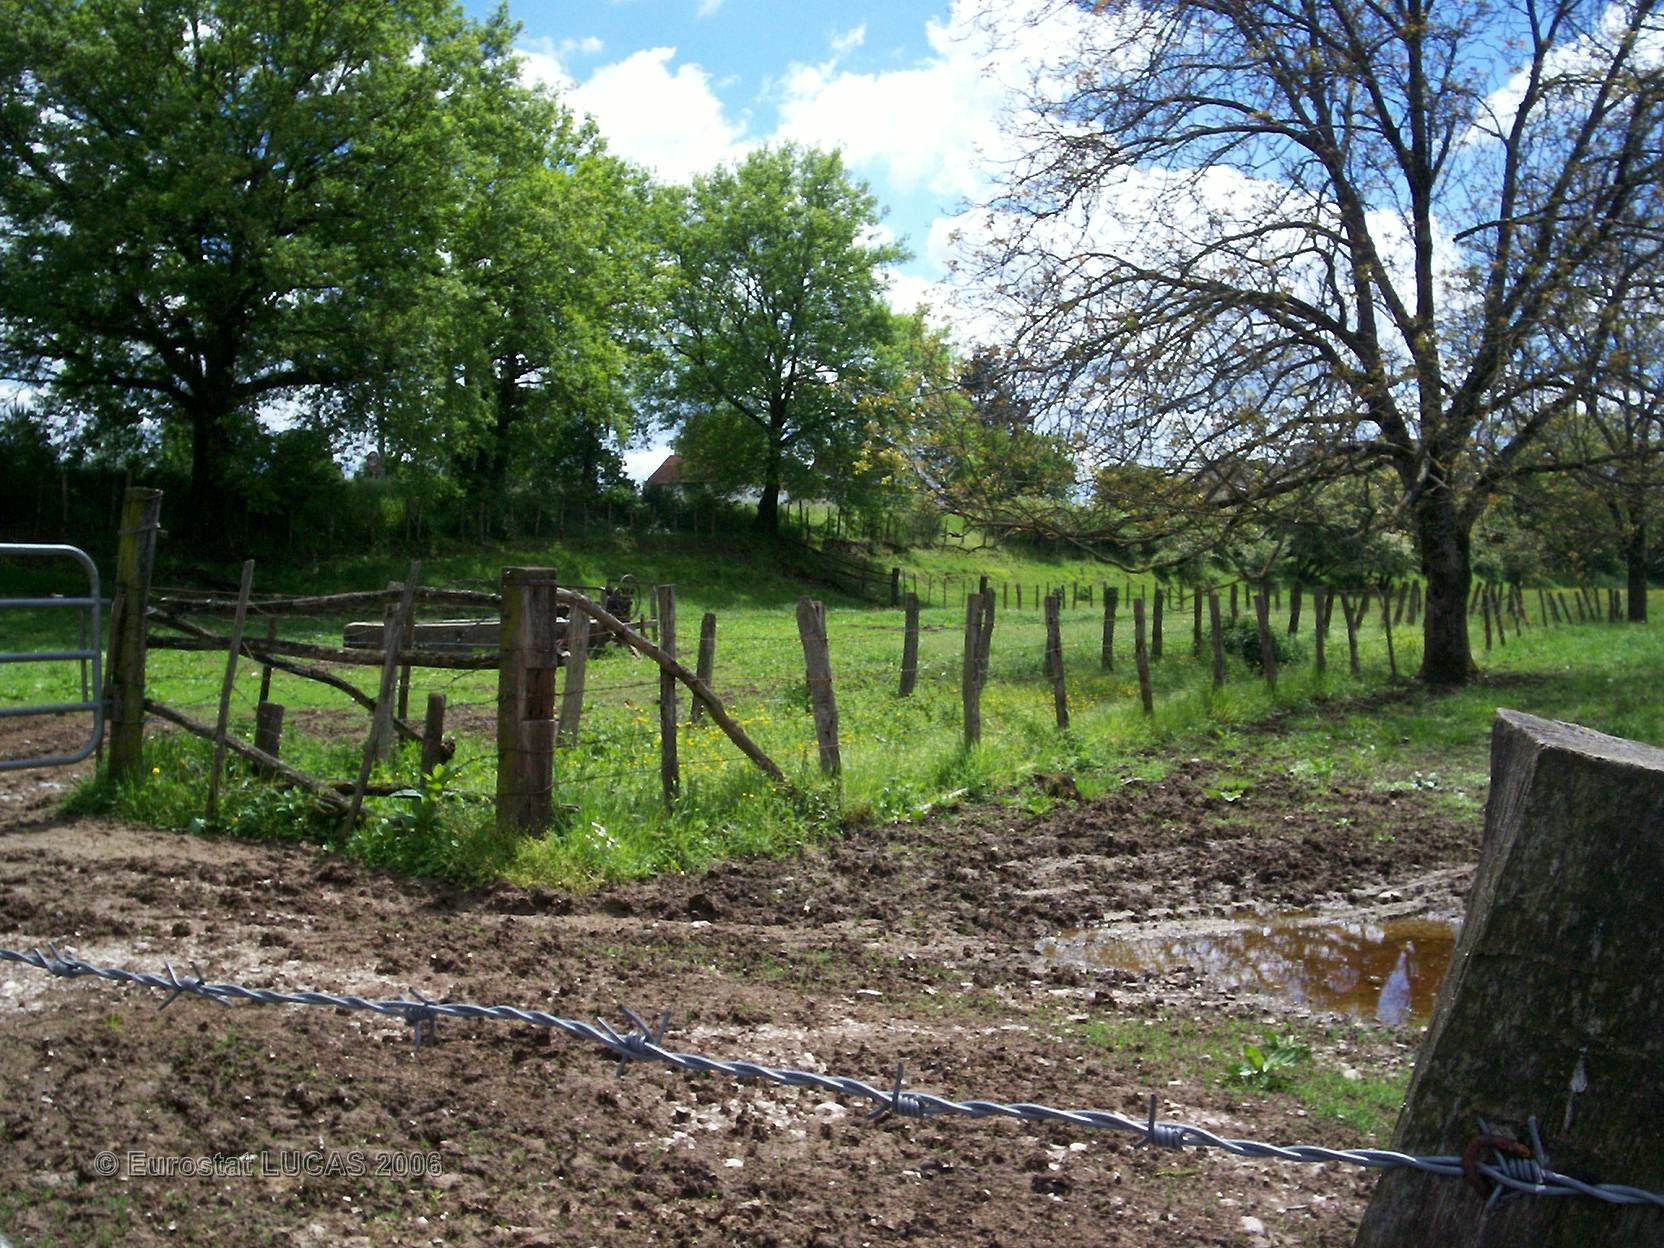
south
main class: Grassland
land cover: Grassland without tree/shrub cover
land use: Agriculture (excluding fallow land and kitchen gardens)
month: May
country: FR
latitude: 44.9354
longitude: 1.8501
